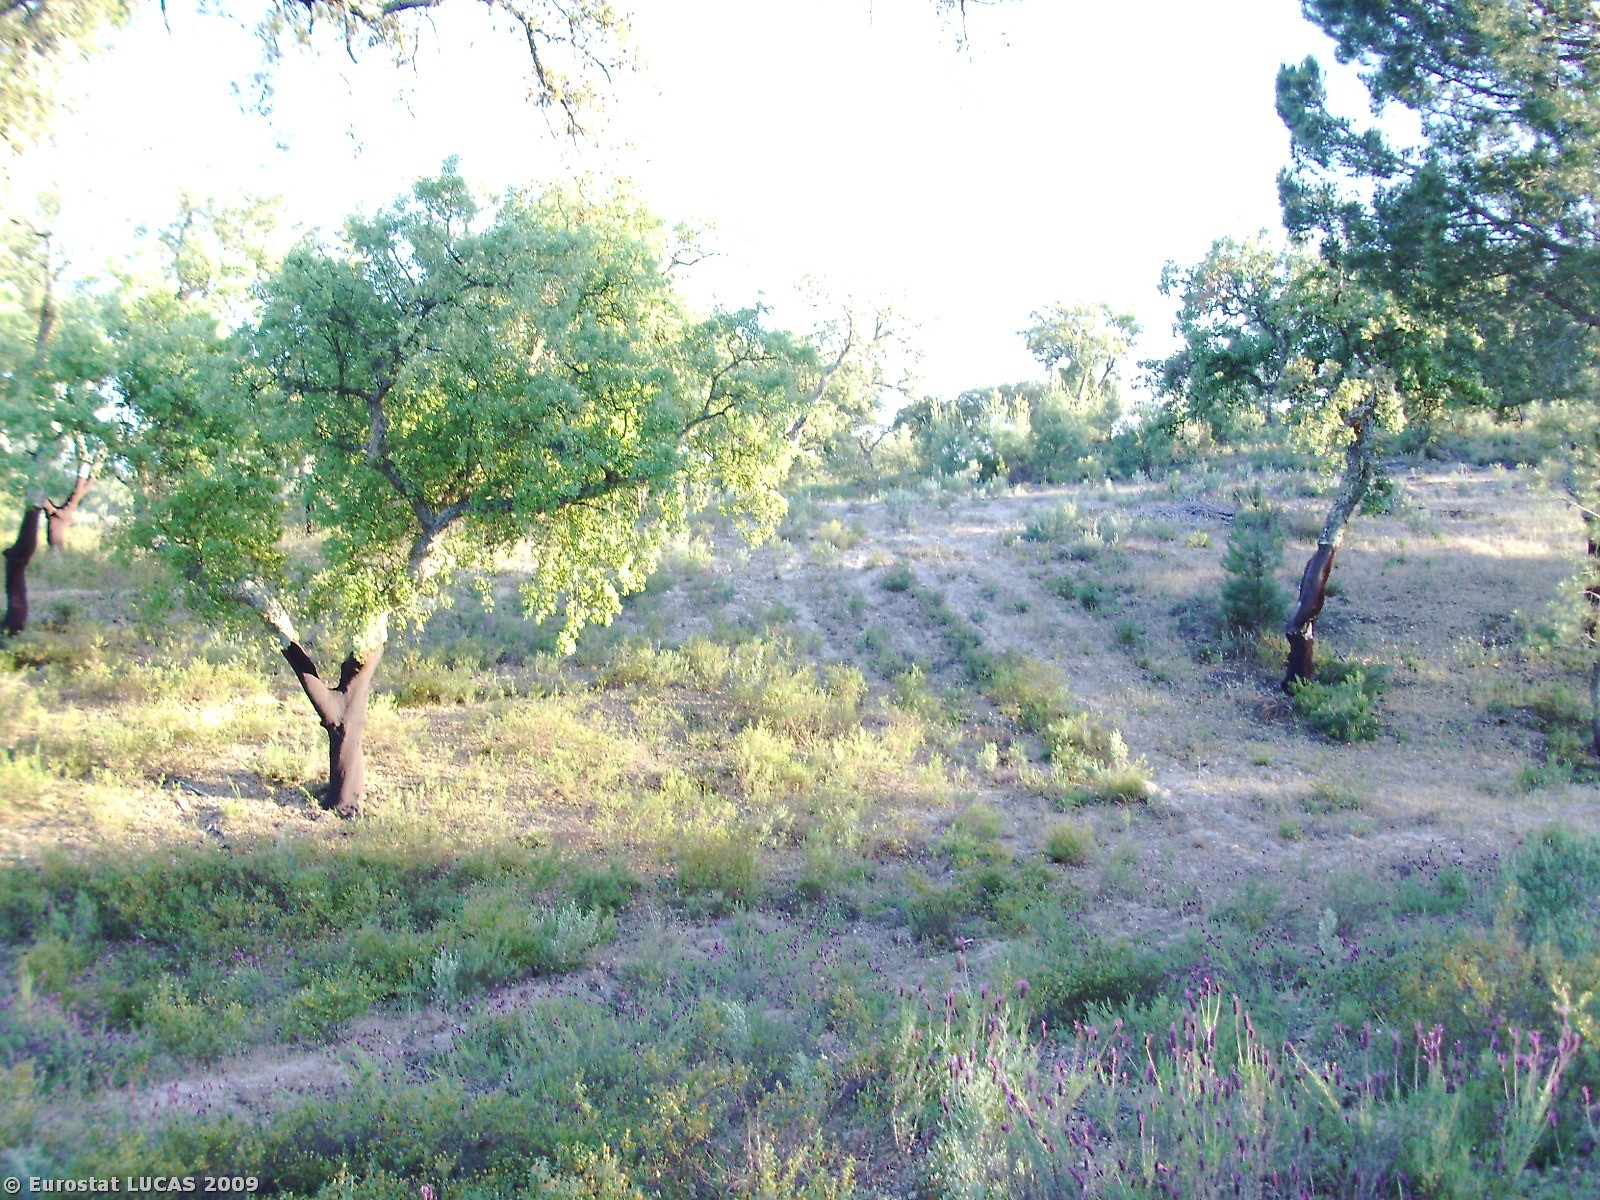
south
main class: Woodland
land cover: Broadleaved woodland
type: broadleaved evergreen forest
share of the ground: 25 - 50 %
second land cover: Spontaneously vegetated surfaces
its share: 50 - 75 %
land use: Forestry
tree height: > 5 m
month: May
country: PT
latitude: 39.1989
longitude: -7.9895
